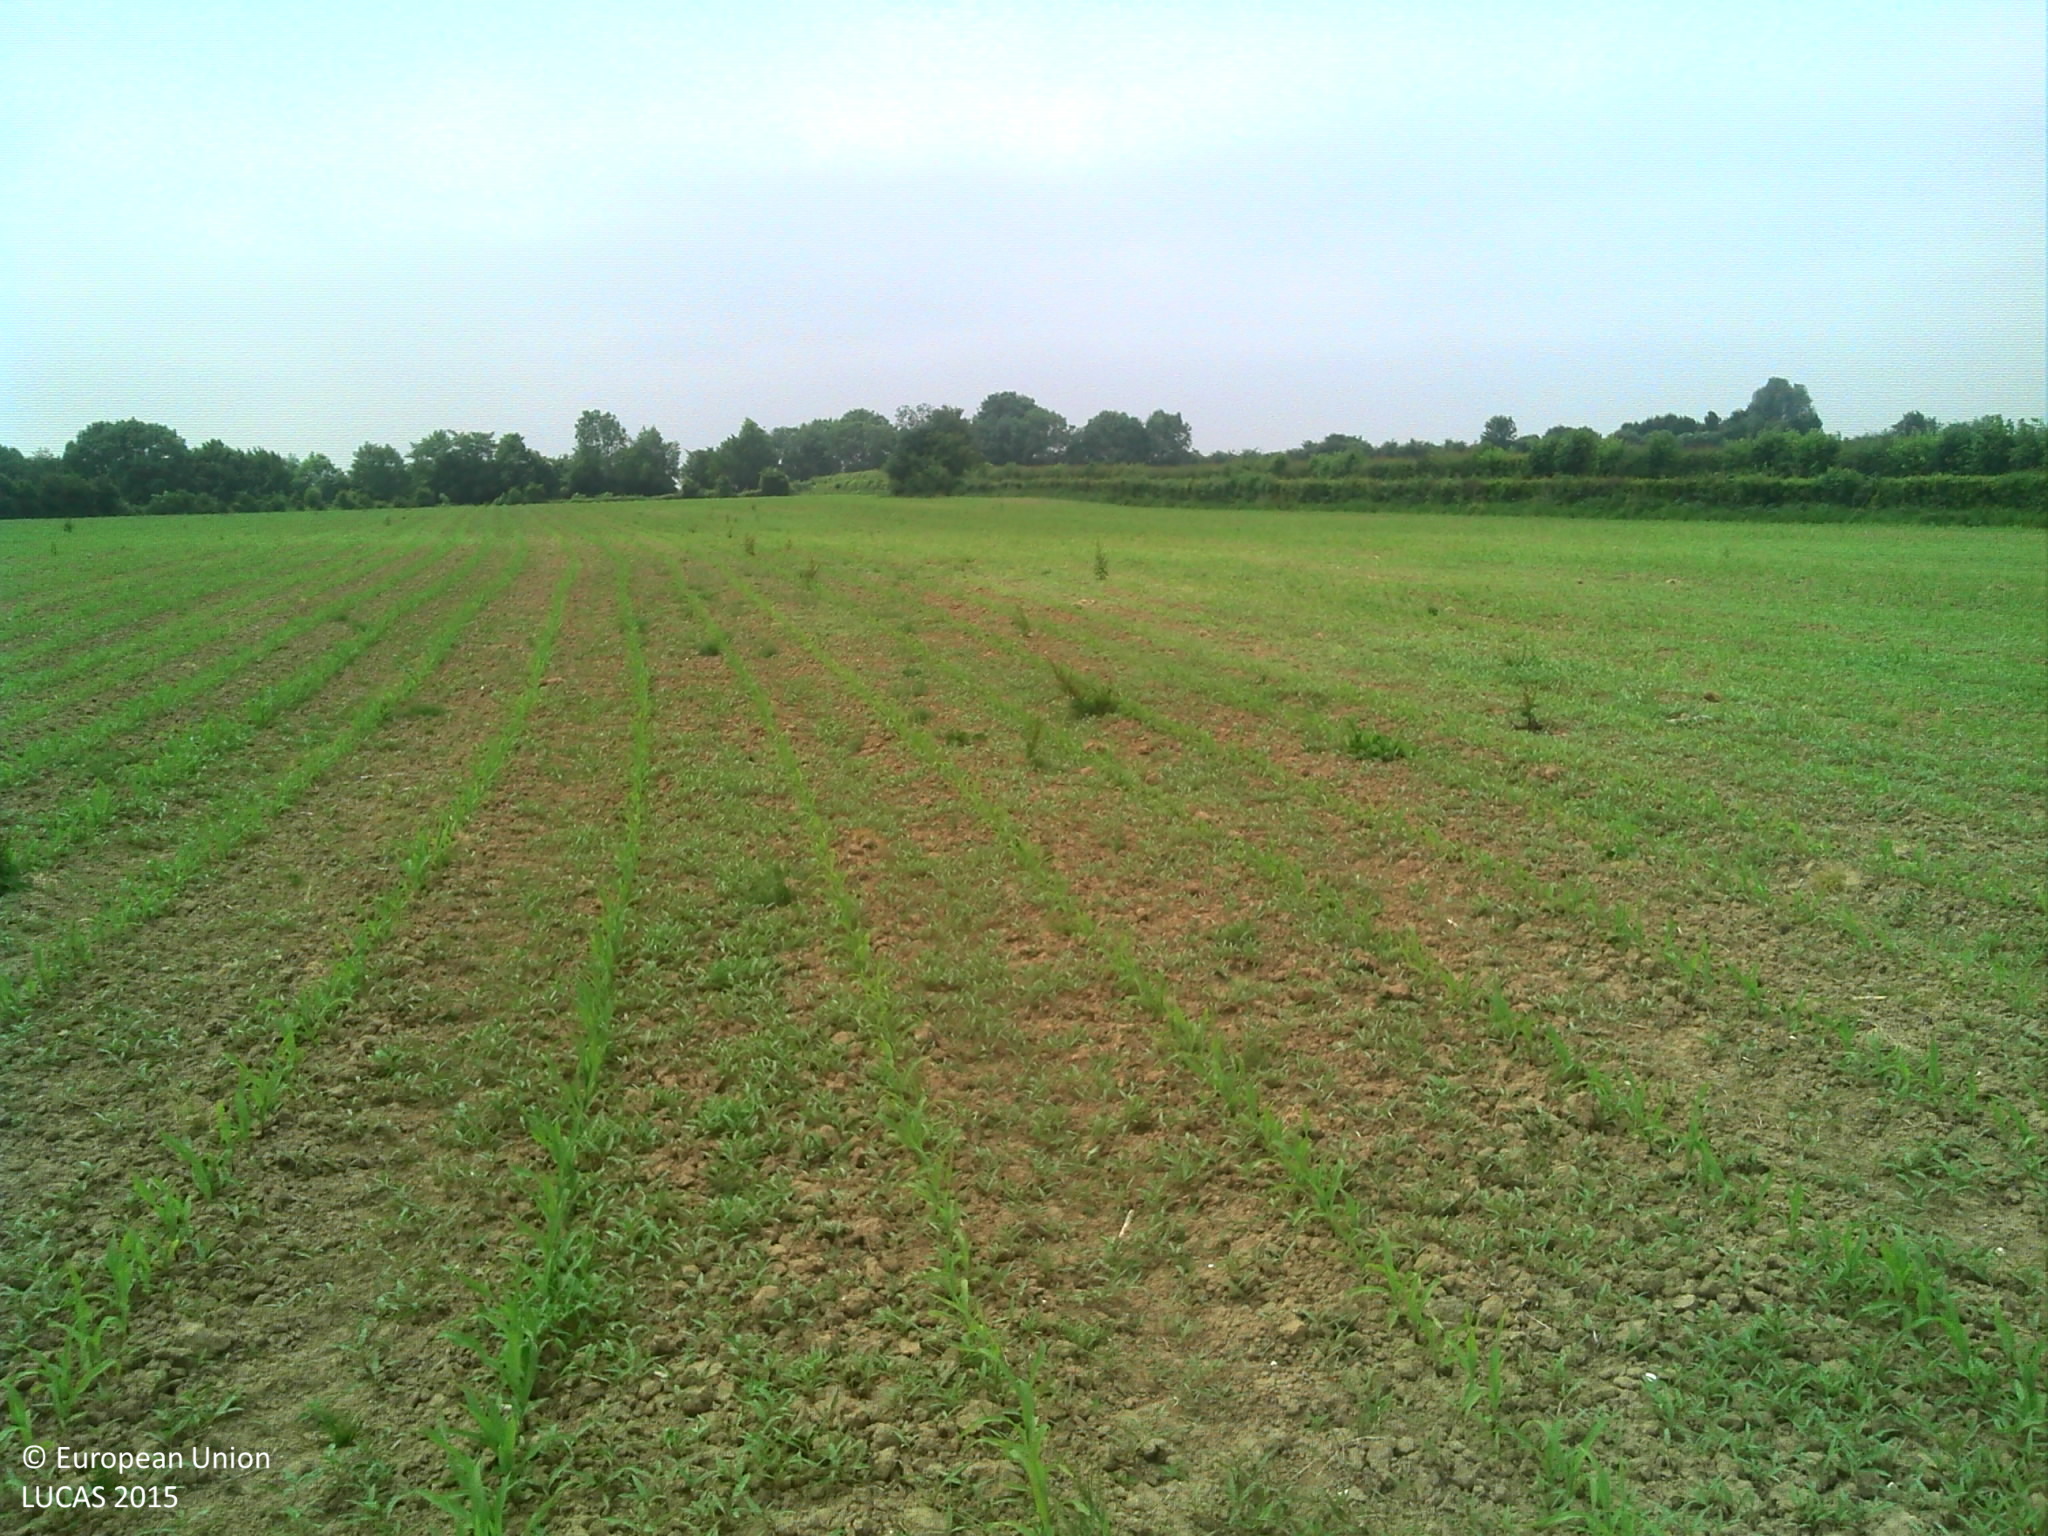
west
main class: Cropland
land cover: Maize
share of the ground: 10 - 25 %
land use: Agriculture (excluding fallow land and kitchen gardens)
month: June
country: FR
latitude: 49.9534
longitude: 3.9873
